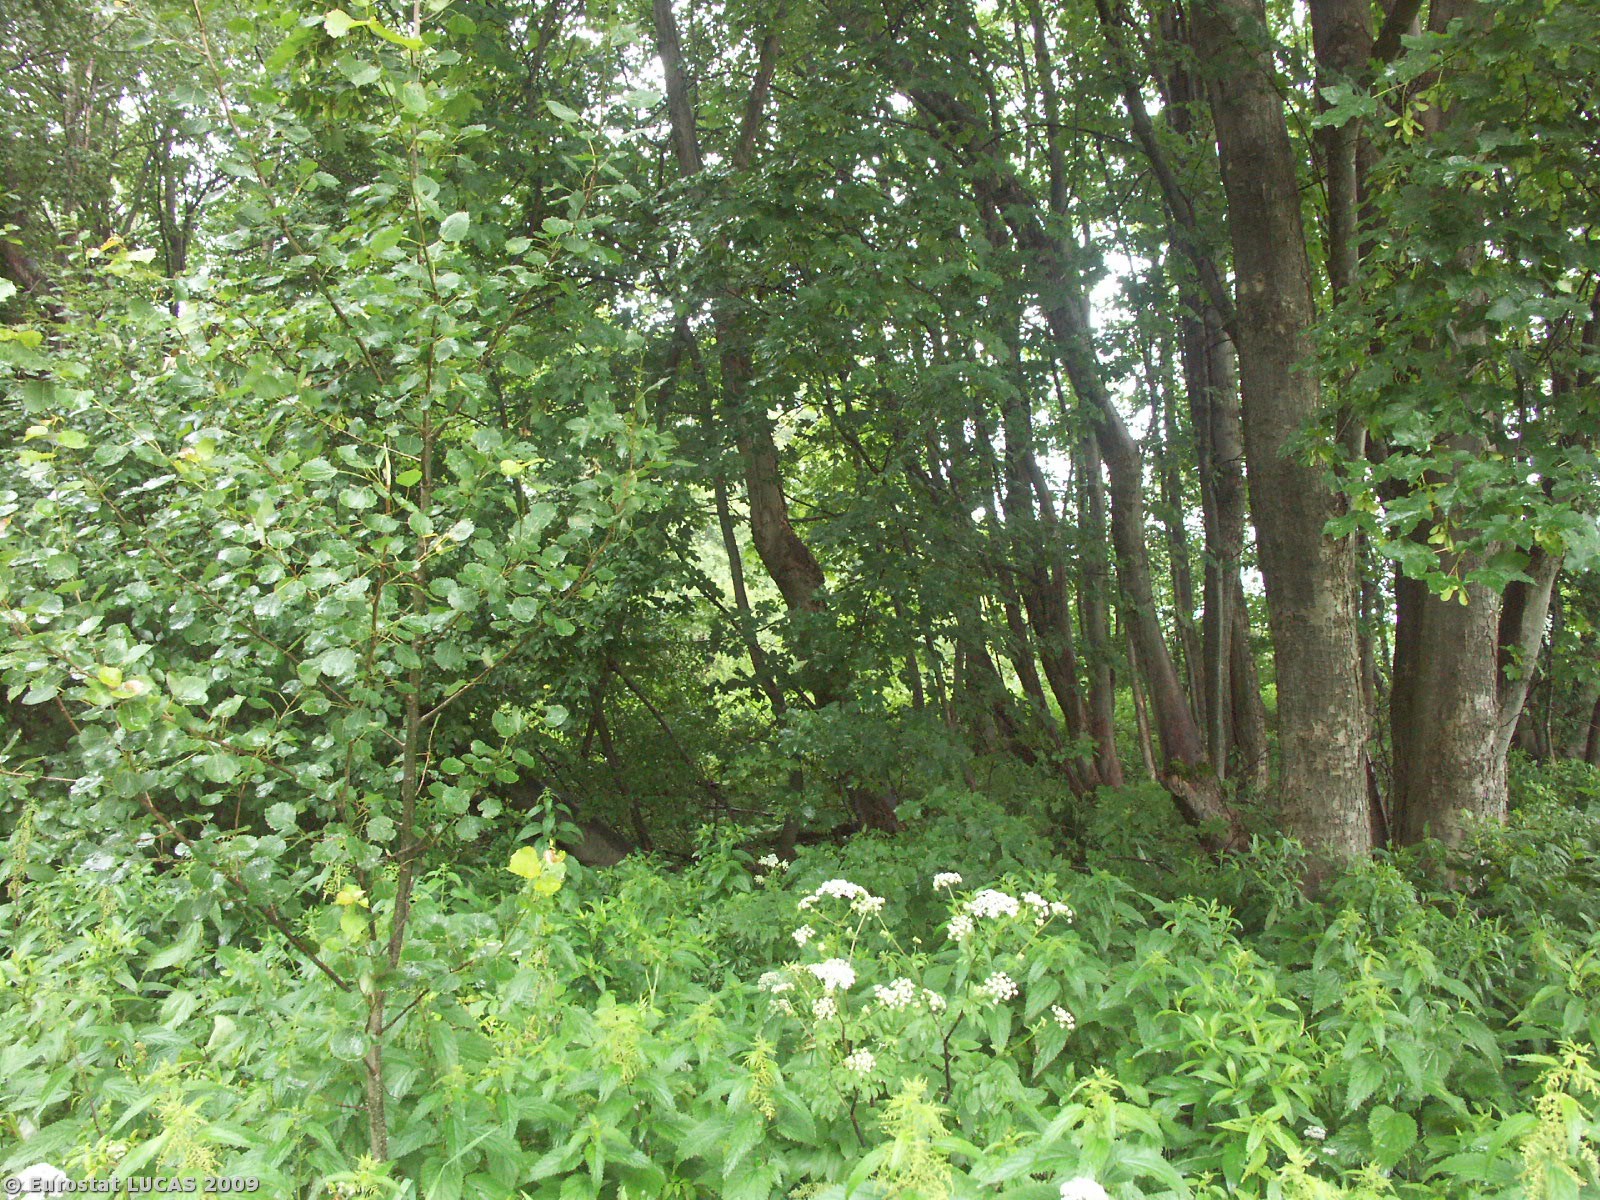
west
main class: Woodland
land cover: Broadleaved woodland
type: mesophytic deciduous forest
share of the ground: > 75 %
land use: Forestry
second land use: Nature reserves
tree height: > 5 m
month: July
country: CZ
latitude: 49.9197
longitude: 17.2115
